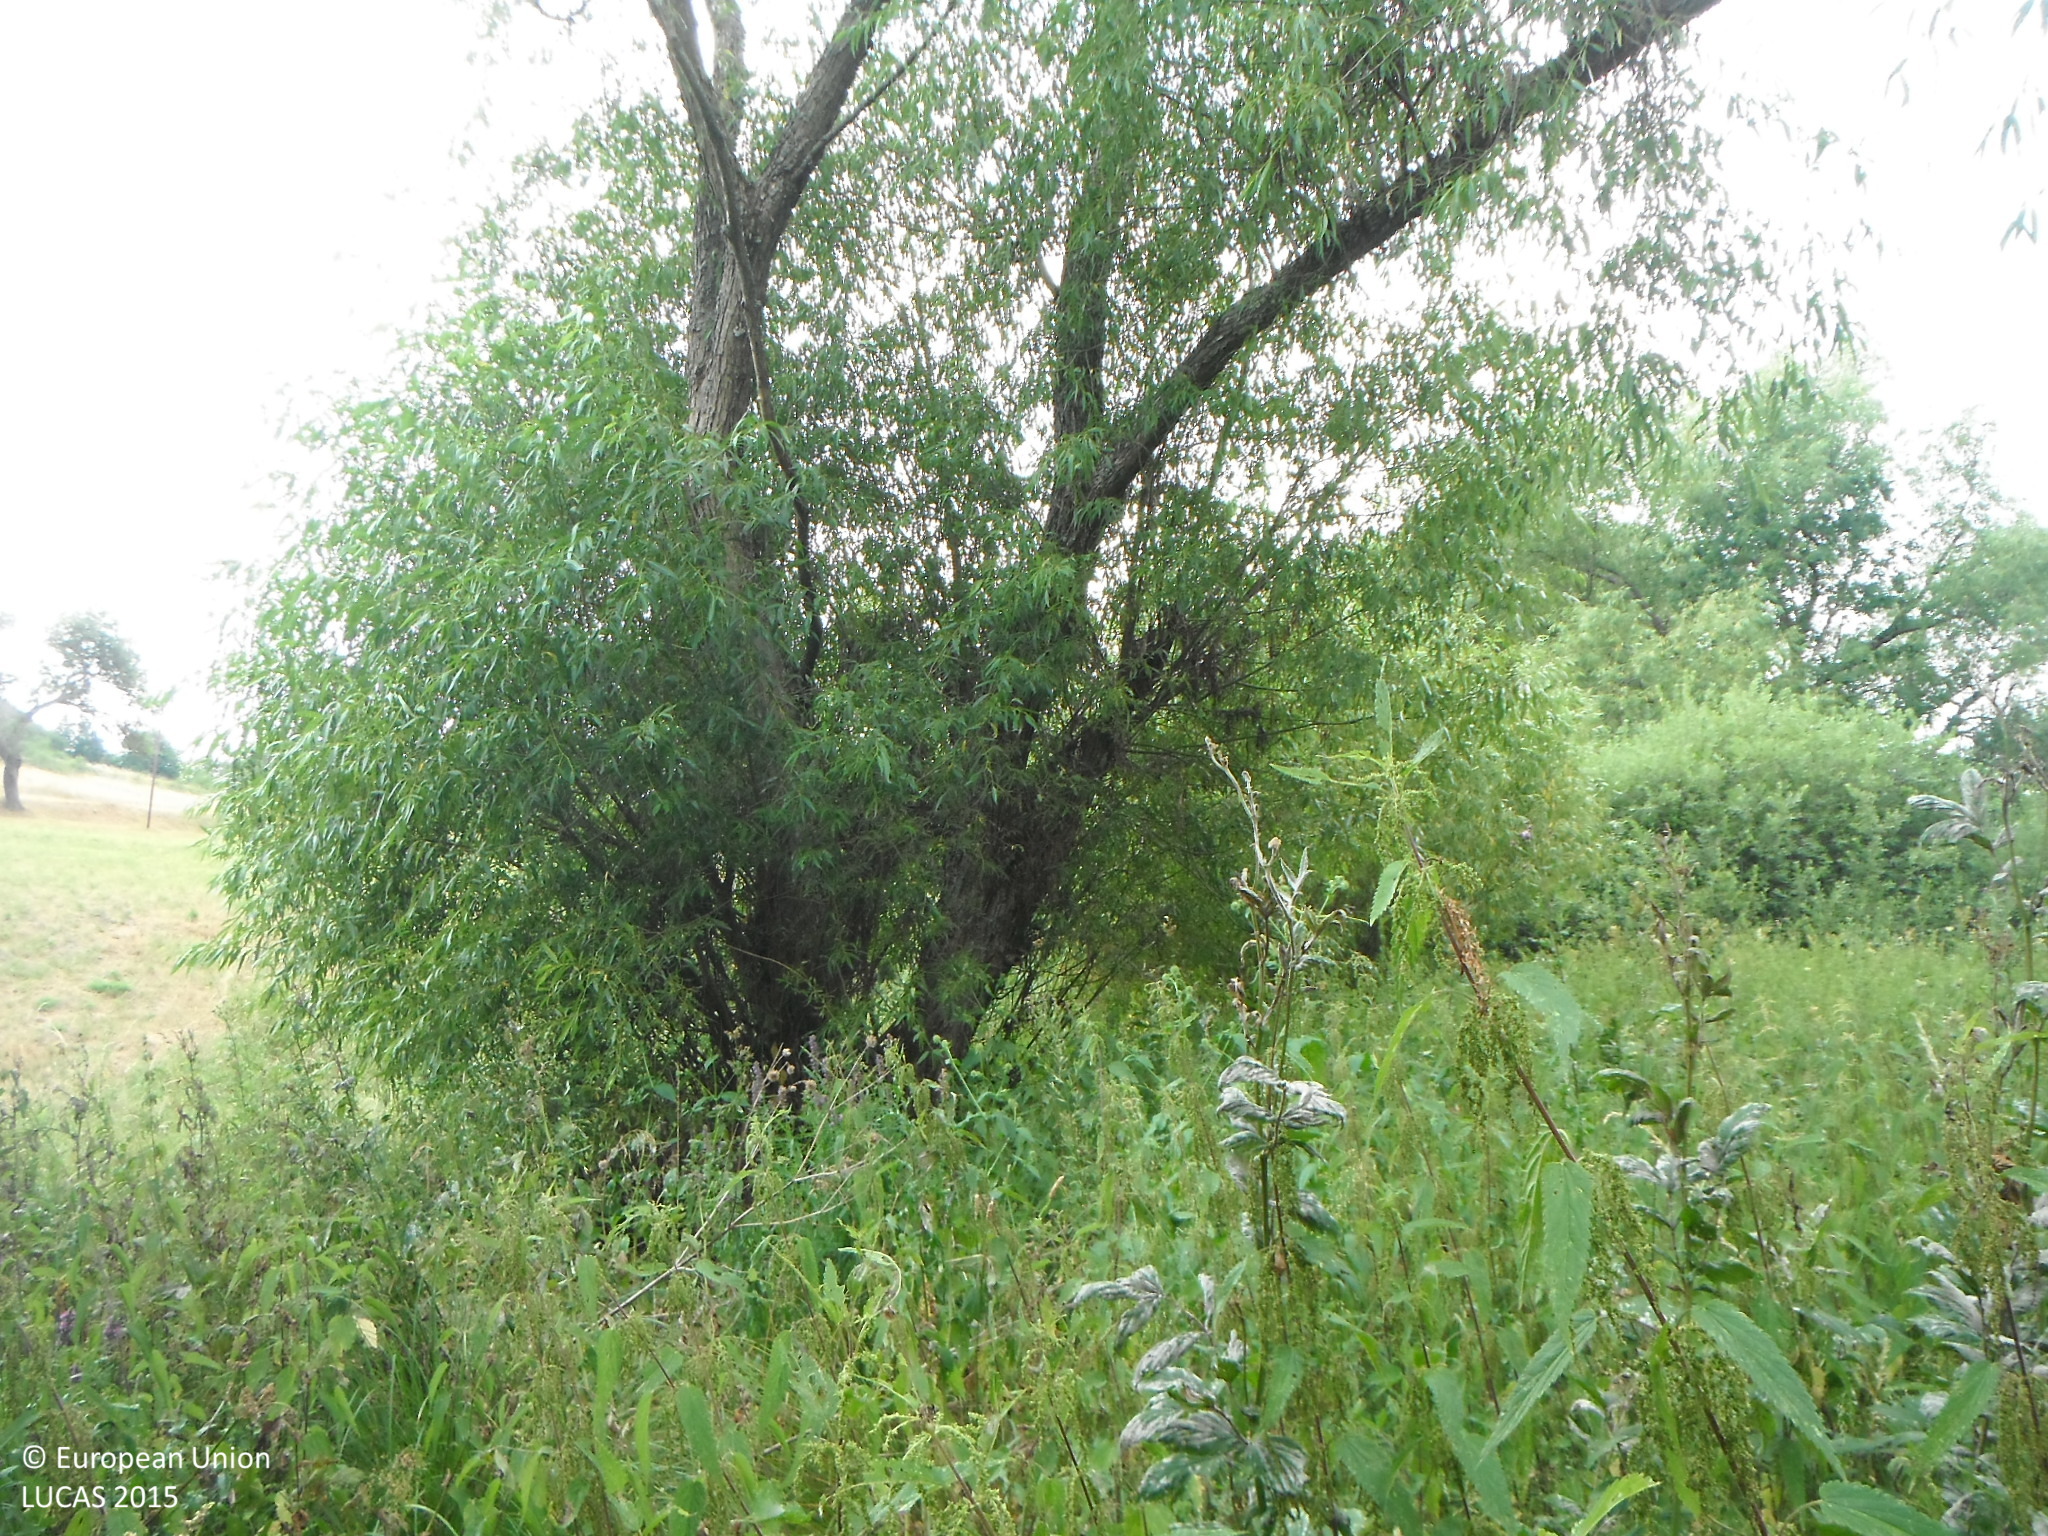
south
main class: Woodland
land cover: Broadleaved woodland
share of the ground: > 75 %
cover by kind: broadleaved forest trees 90 %, herbaceous plants 10 %
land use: Semi-natural and natural areas not in use
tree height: > 5 m
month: July
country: SK
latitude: 48.3666
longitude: 19.1599
